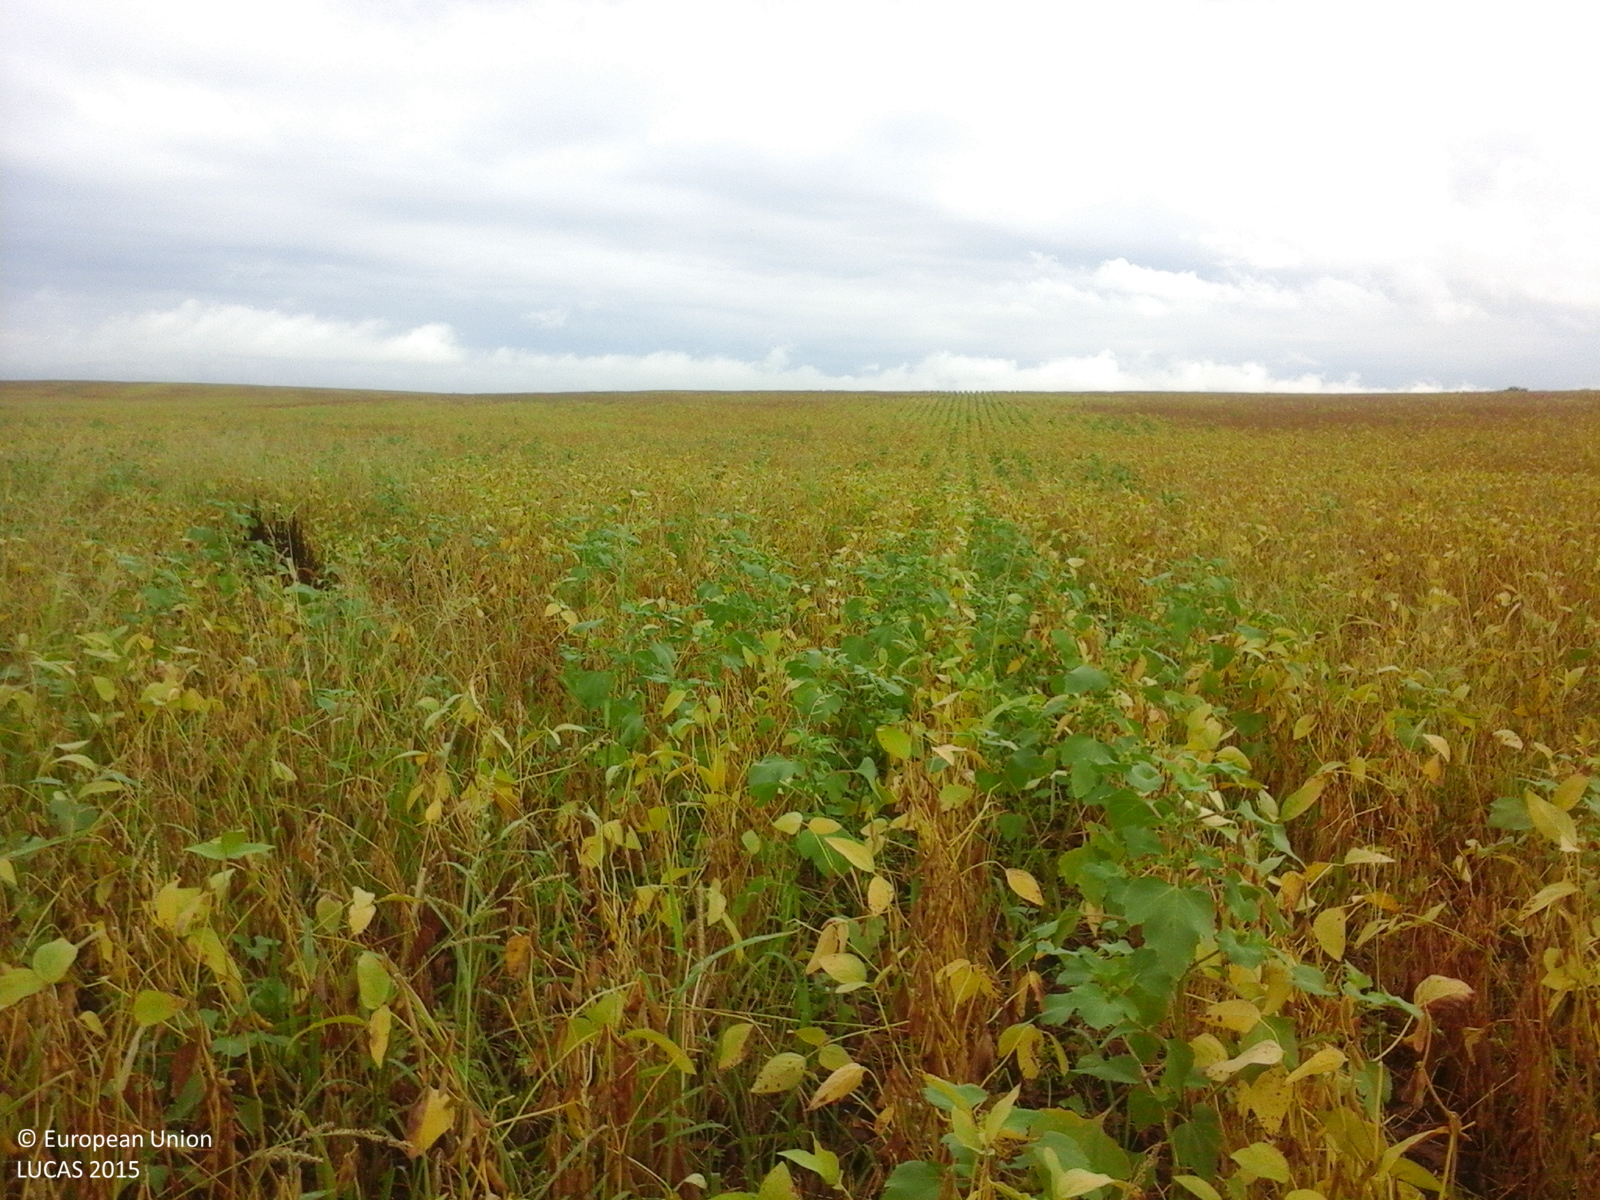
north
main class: Cropland
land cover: Soya
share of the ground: > 75 %
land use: Agriculture (excluding fallow land and kitchen gardens)
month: August
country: RO
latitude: 45.5978
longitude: 21.5327
